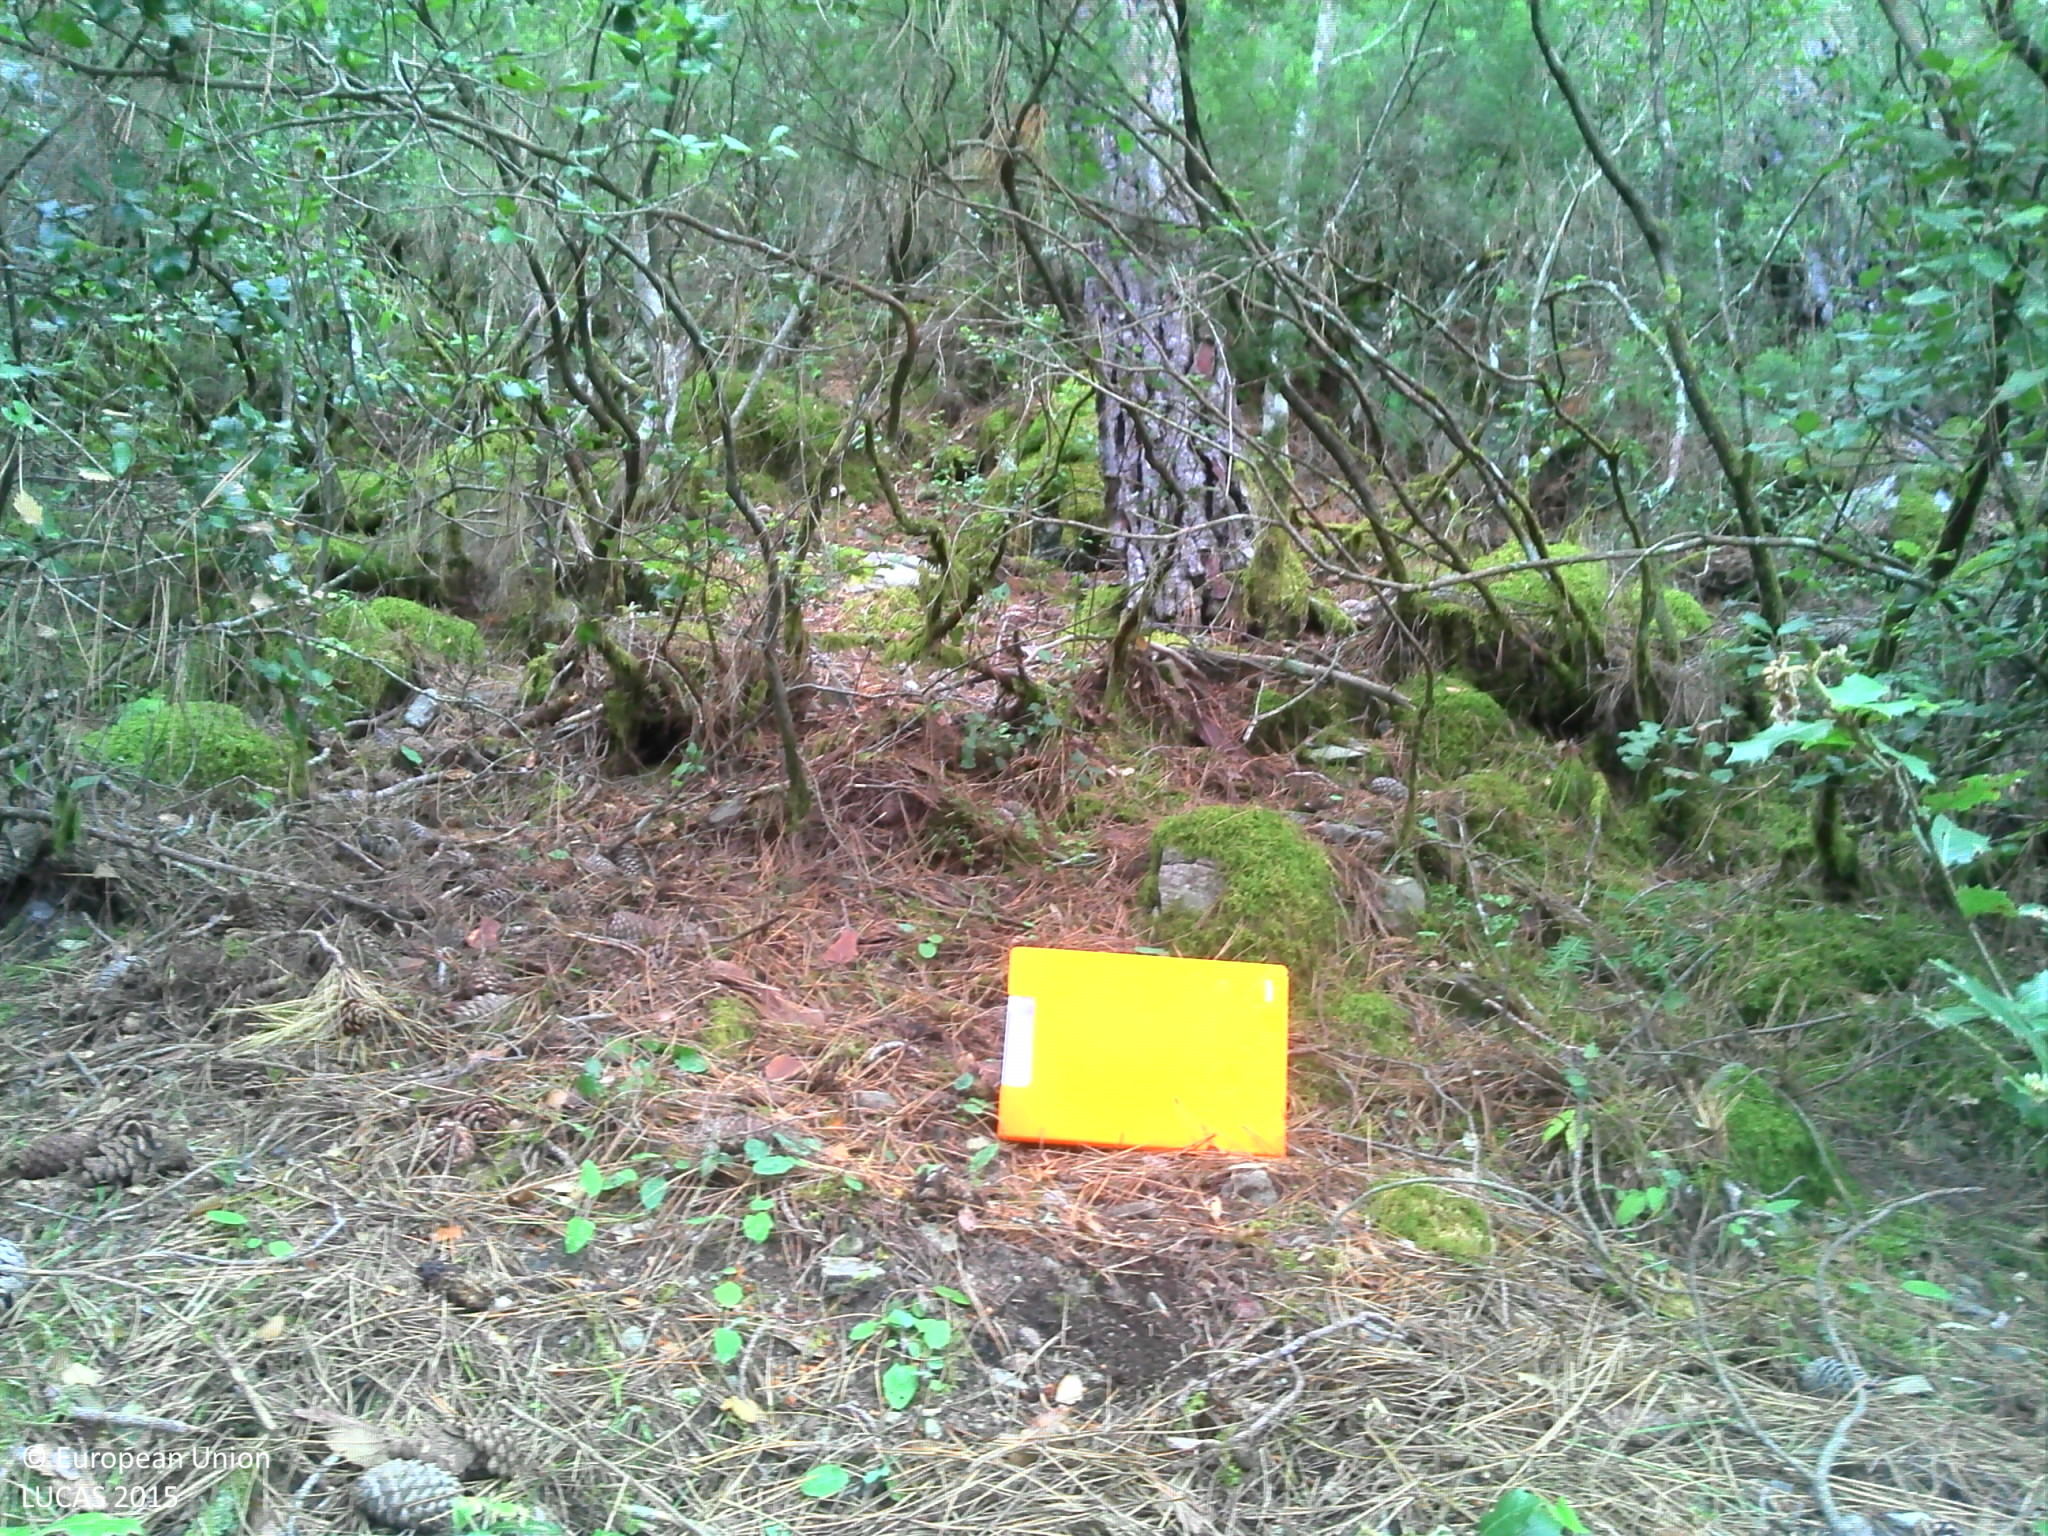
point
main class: Woodland
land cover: Pine dominated coniferous woodland
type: coniferous forest of the mediterranean region
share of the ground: > 75 %
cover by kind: coniferous forest trees 75 %, broadleaved forest trees 15 %, shrubs 10 %
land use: Forestry
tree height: > 5 m
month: June
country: FR
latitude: 42.3986
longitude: 9.2858
